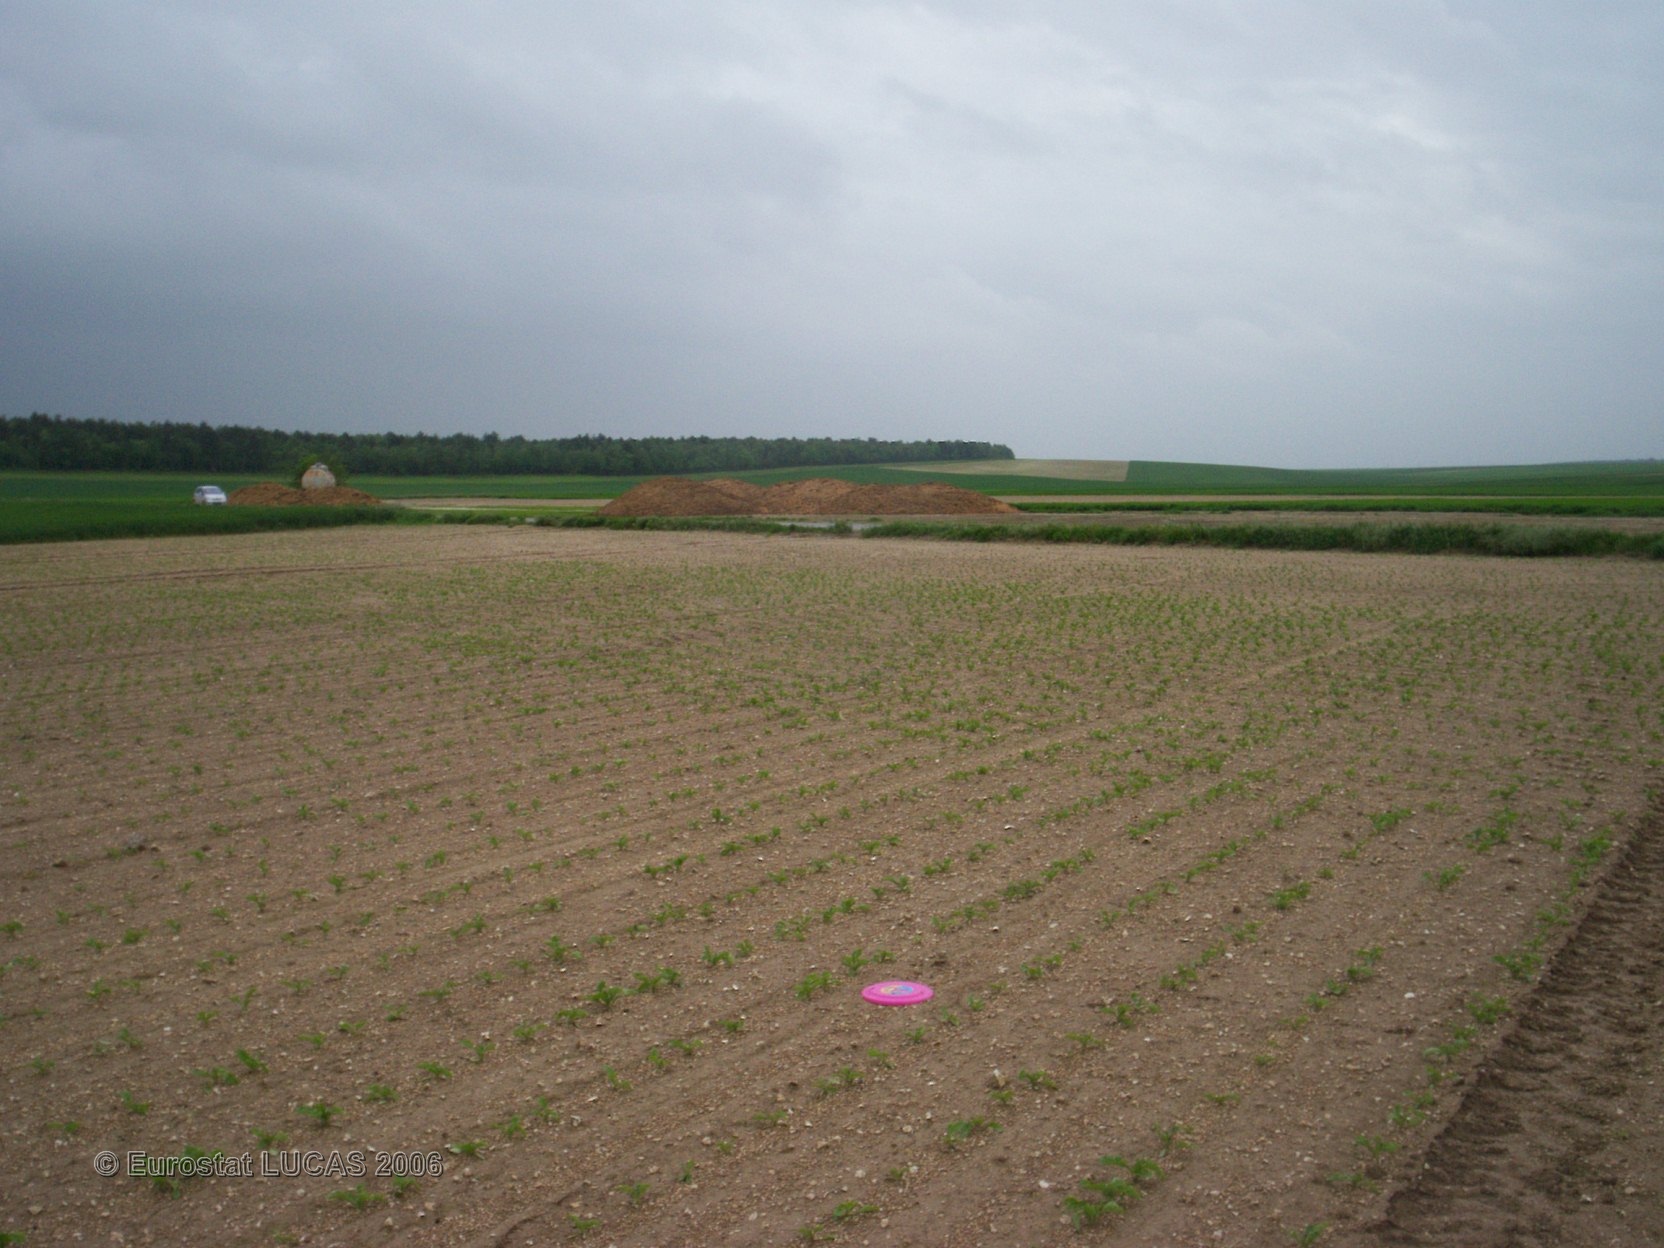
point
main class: Cropland
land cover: Sugar beet
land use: Agriculture (excluding fallow land and kitchen gardens)
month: May
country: FR
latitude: 49.3764
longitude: 4.3351
